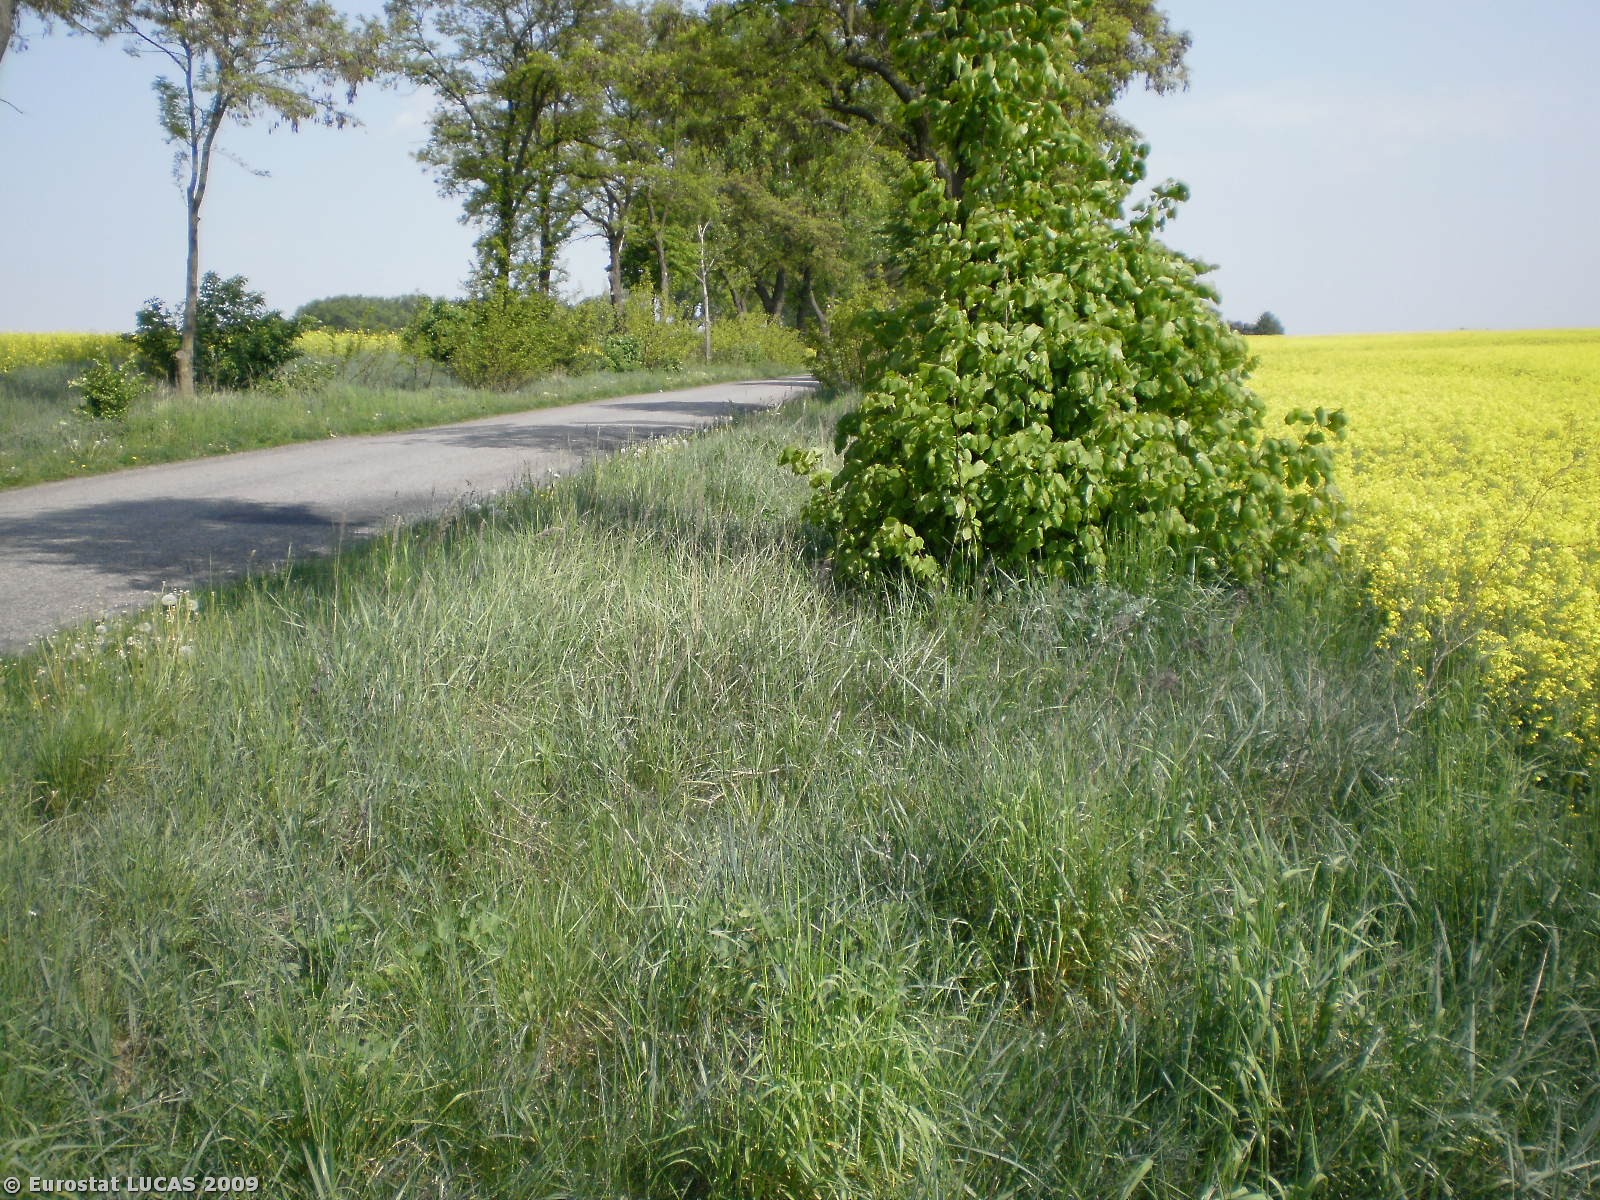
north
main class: Cropland
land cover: Rape and turnip rape
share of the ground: > 75 %
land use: Agriculture (excluding fallow land and kitchen gardens)
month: May
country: PL
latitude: 53.3662
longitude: 18.0856
